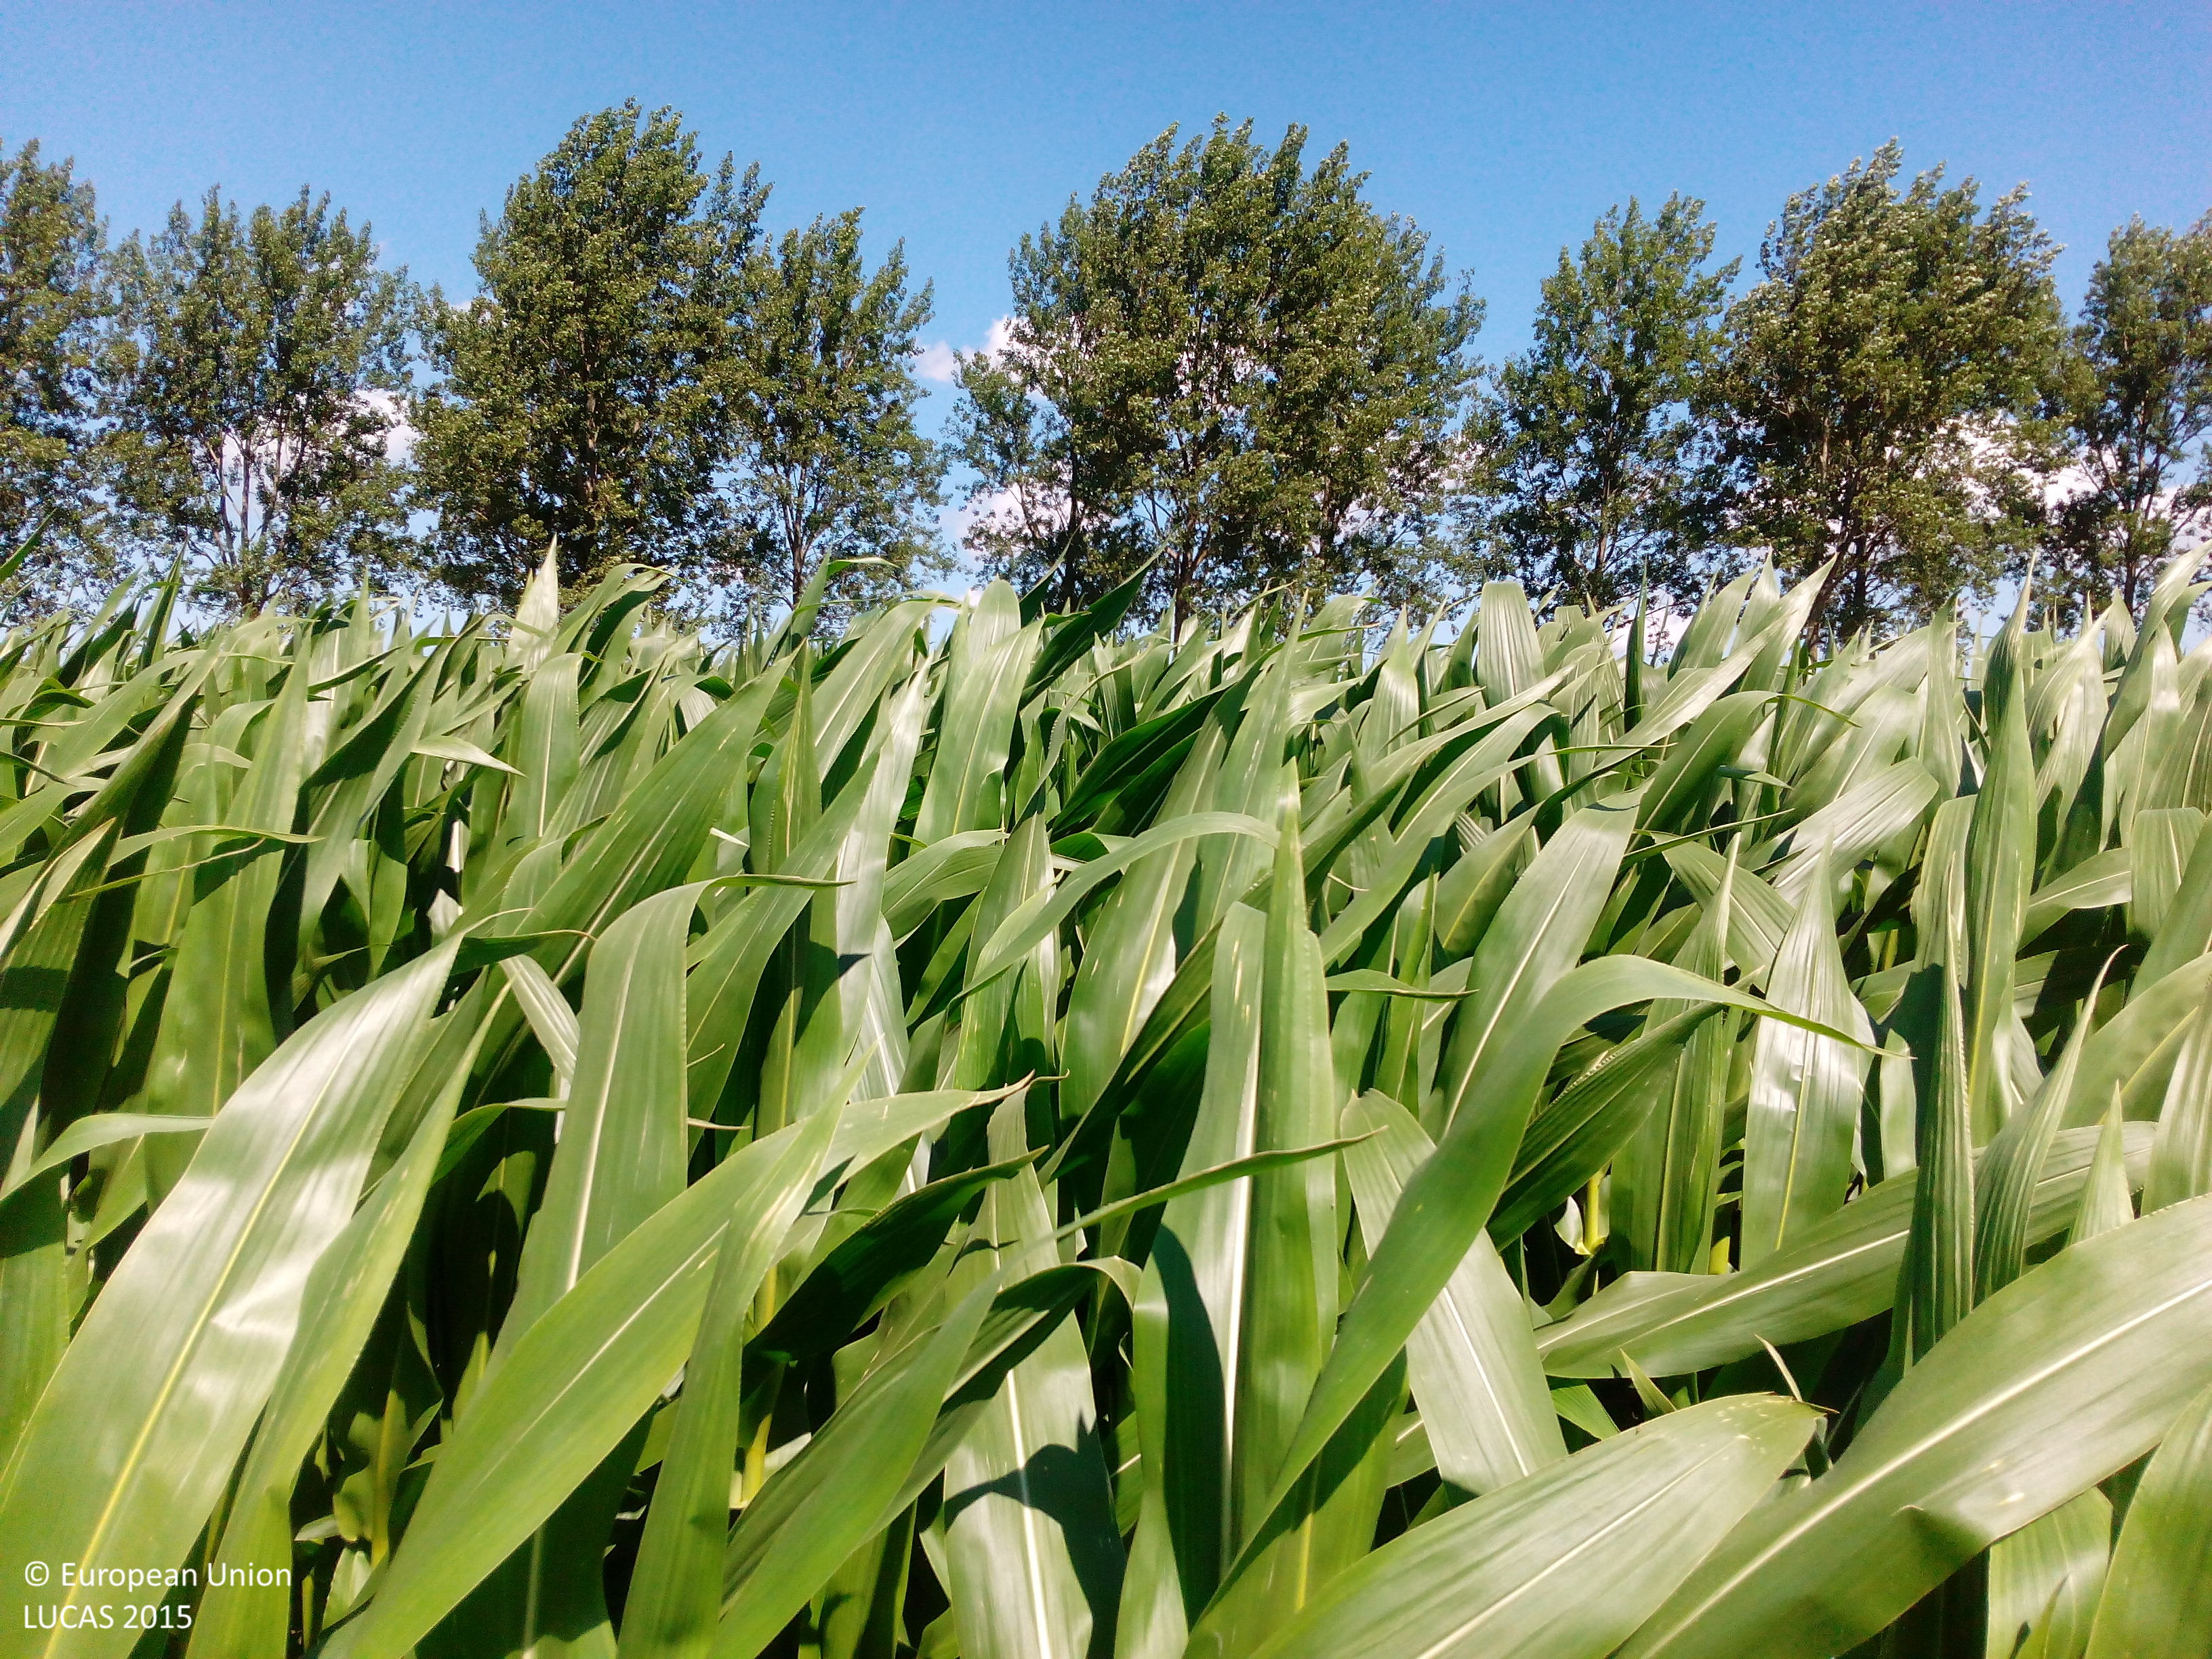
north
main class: Grassland
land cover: Grassland without tree/shrub cover
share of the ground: > 75 %
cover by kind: herbaceous plants 100 %
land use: Agriculture (excluding fallow land and kitchen gardens)
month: July
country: NL
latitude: 52.1673
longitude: 4.6599
